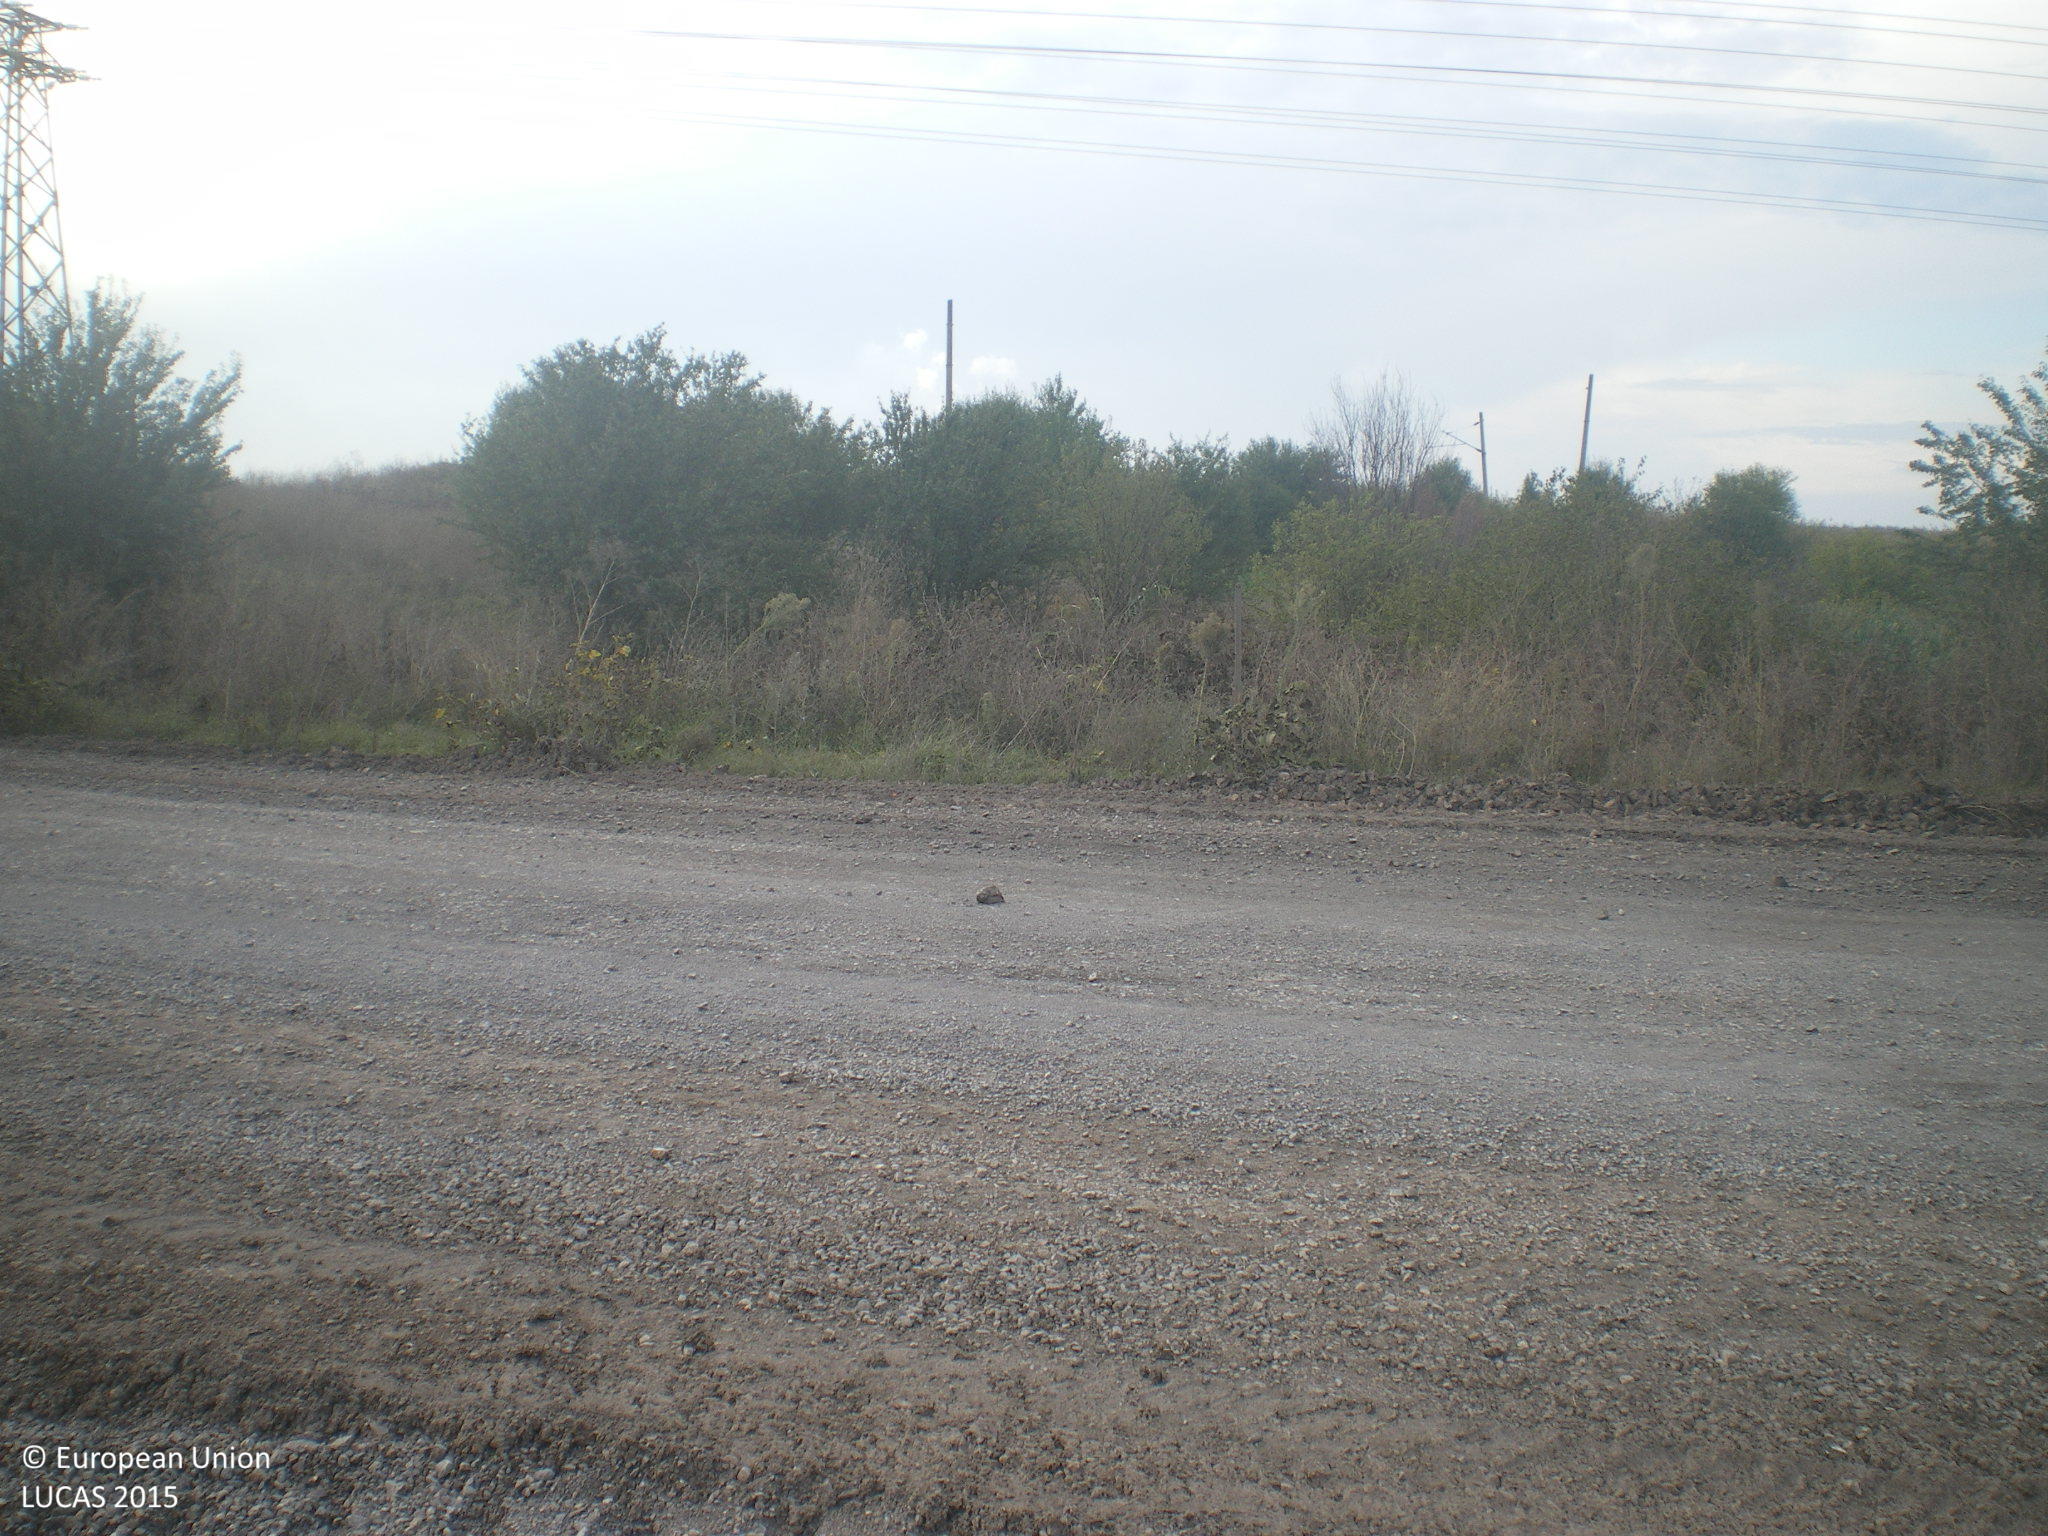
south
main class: Grassland
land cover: Grassland with sparse tree/shrub cover
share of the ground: > 75 %
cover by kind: herbaceous plants 90 %, broadleaved forest trees 5 %, shrubs 5 %
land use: Mining and quarrying
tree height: > 5 m
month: October
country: BG
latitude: 42.2518
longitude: 26.0168
